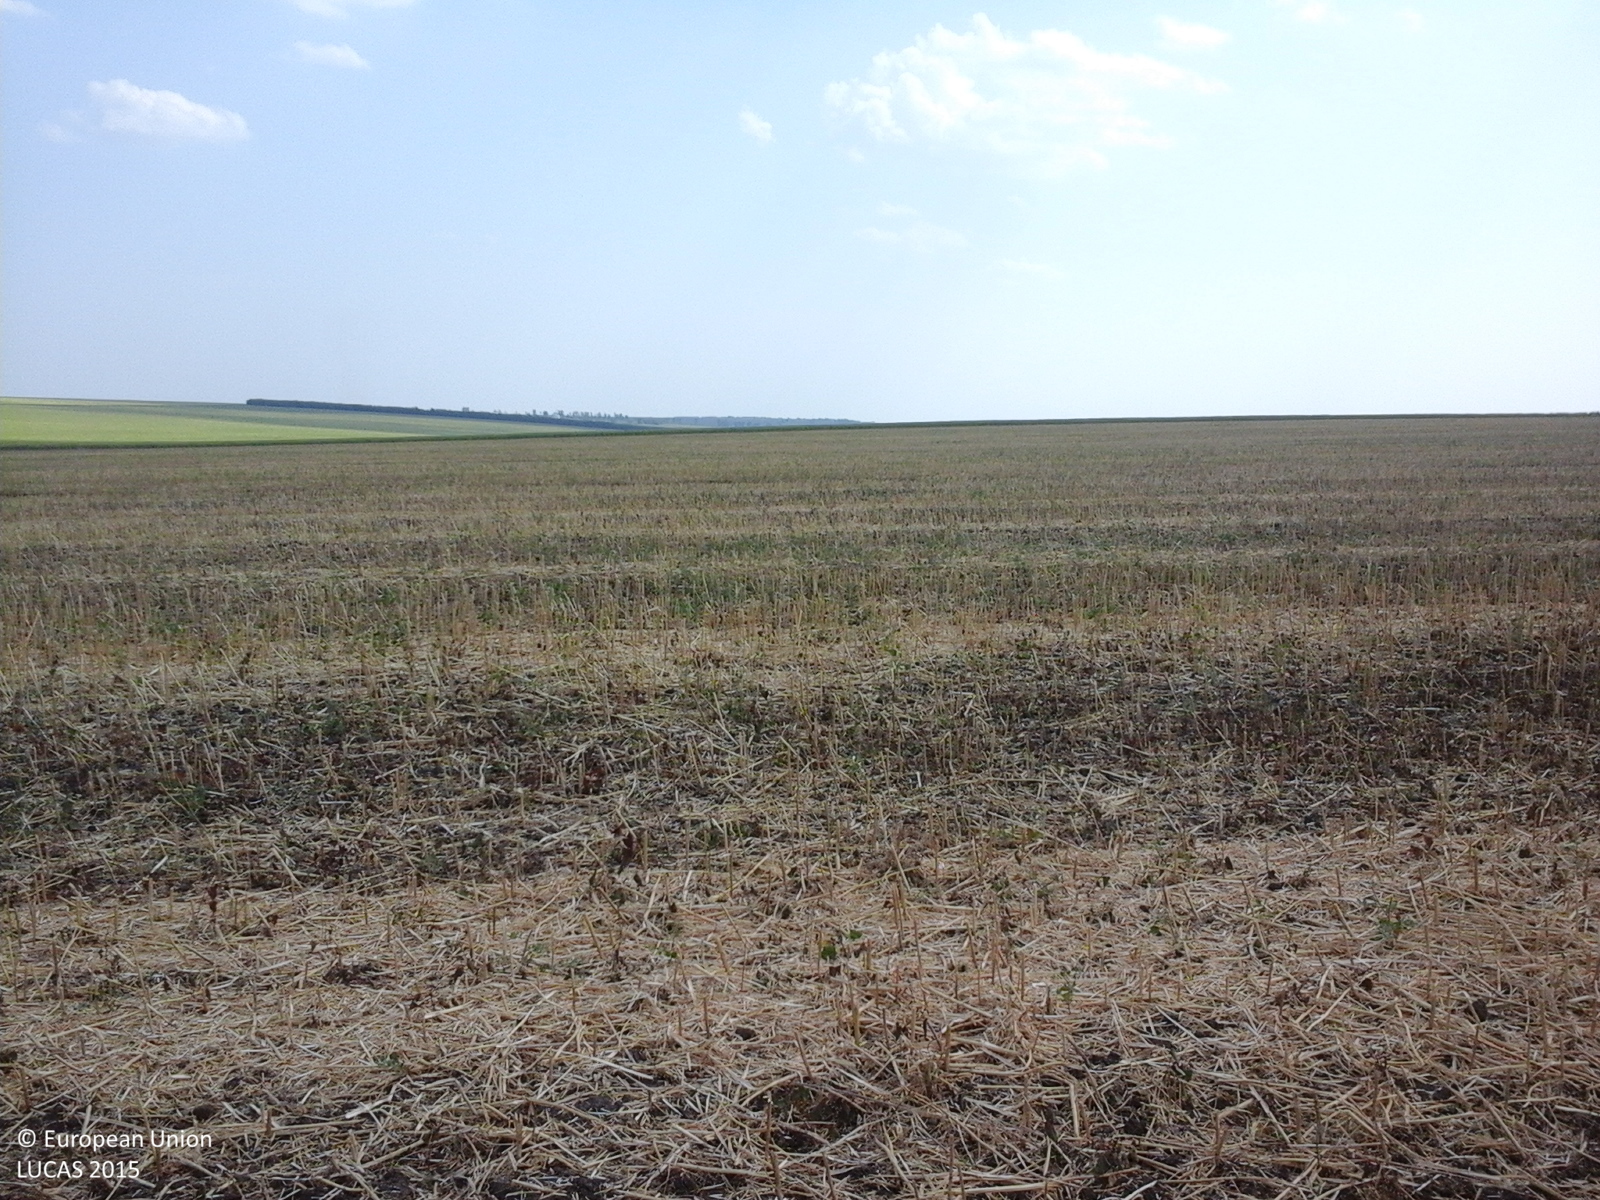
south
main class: Cropland
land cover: Rape and turnip rape
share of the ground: 10 - 25 %
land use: Agriculture (excluding fallow land and kitchen gardens)
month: July
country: RO
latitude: 45.7827
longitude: 27.9057
